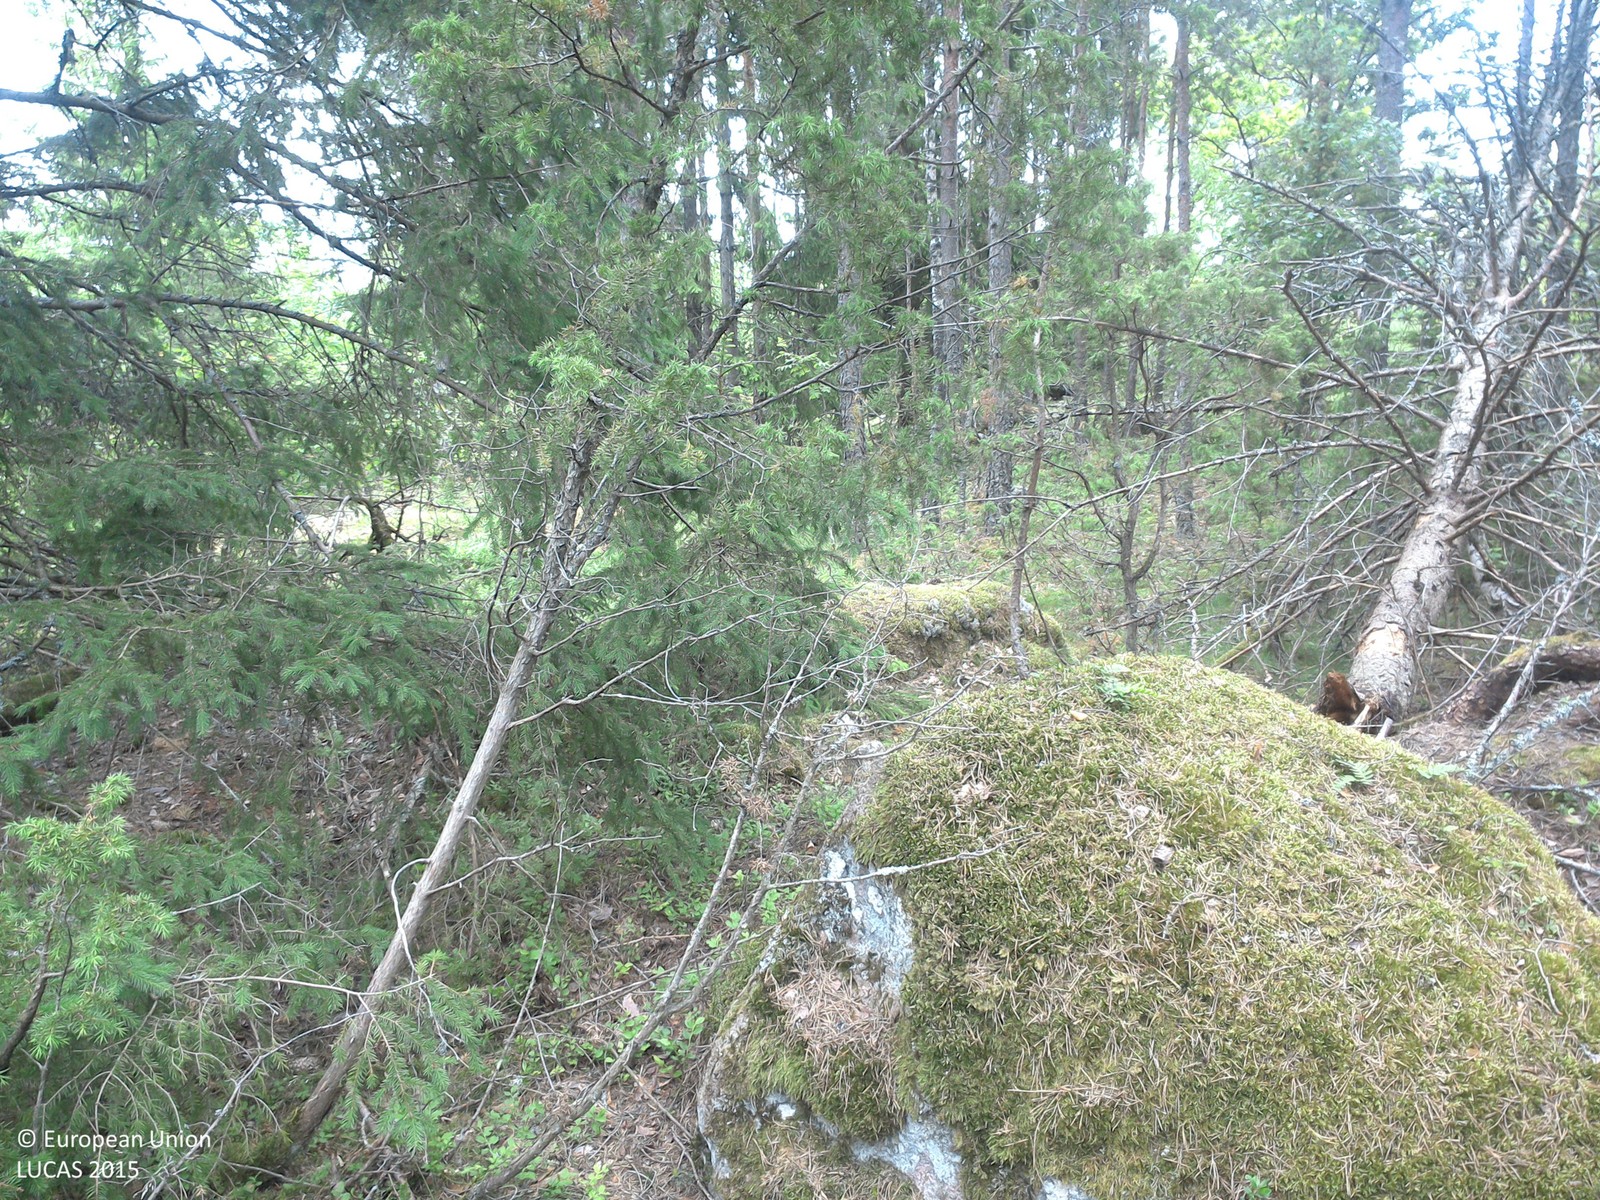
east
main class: Woodland
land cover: Pine dominated coniferous woodland
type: boreal forest
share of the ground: 50 - 75 %
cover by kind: coniferous forest trees 60 %, herbaceous plants 20 %, lichens and mosses 20 %
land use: Agriculture (excluding fallow land and kitchen gardens)
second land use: Forestry
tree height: > 5 m
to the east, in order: Pine dominated coniferous woodland; Spruce dominated coniferous woodland; Spruce dominated mixed woodland; Broadleaved woodland; Spruce dominated coniferous woodland
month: June
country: SE
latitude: 58.3037
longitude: 15.5406
